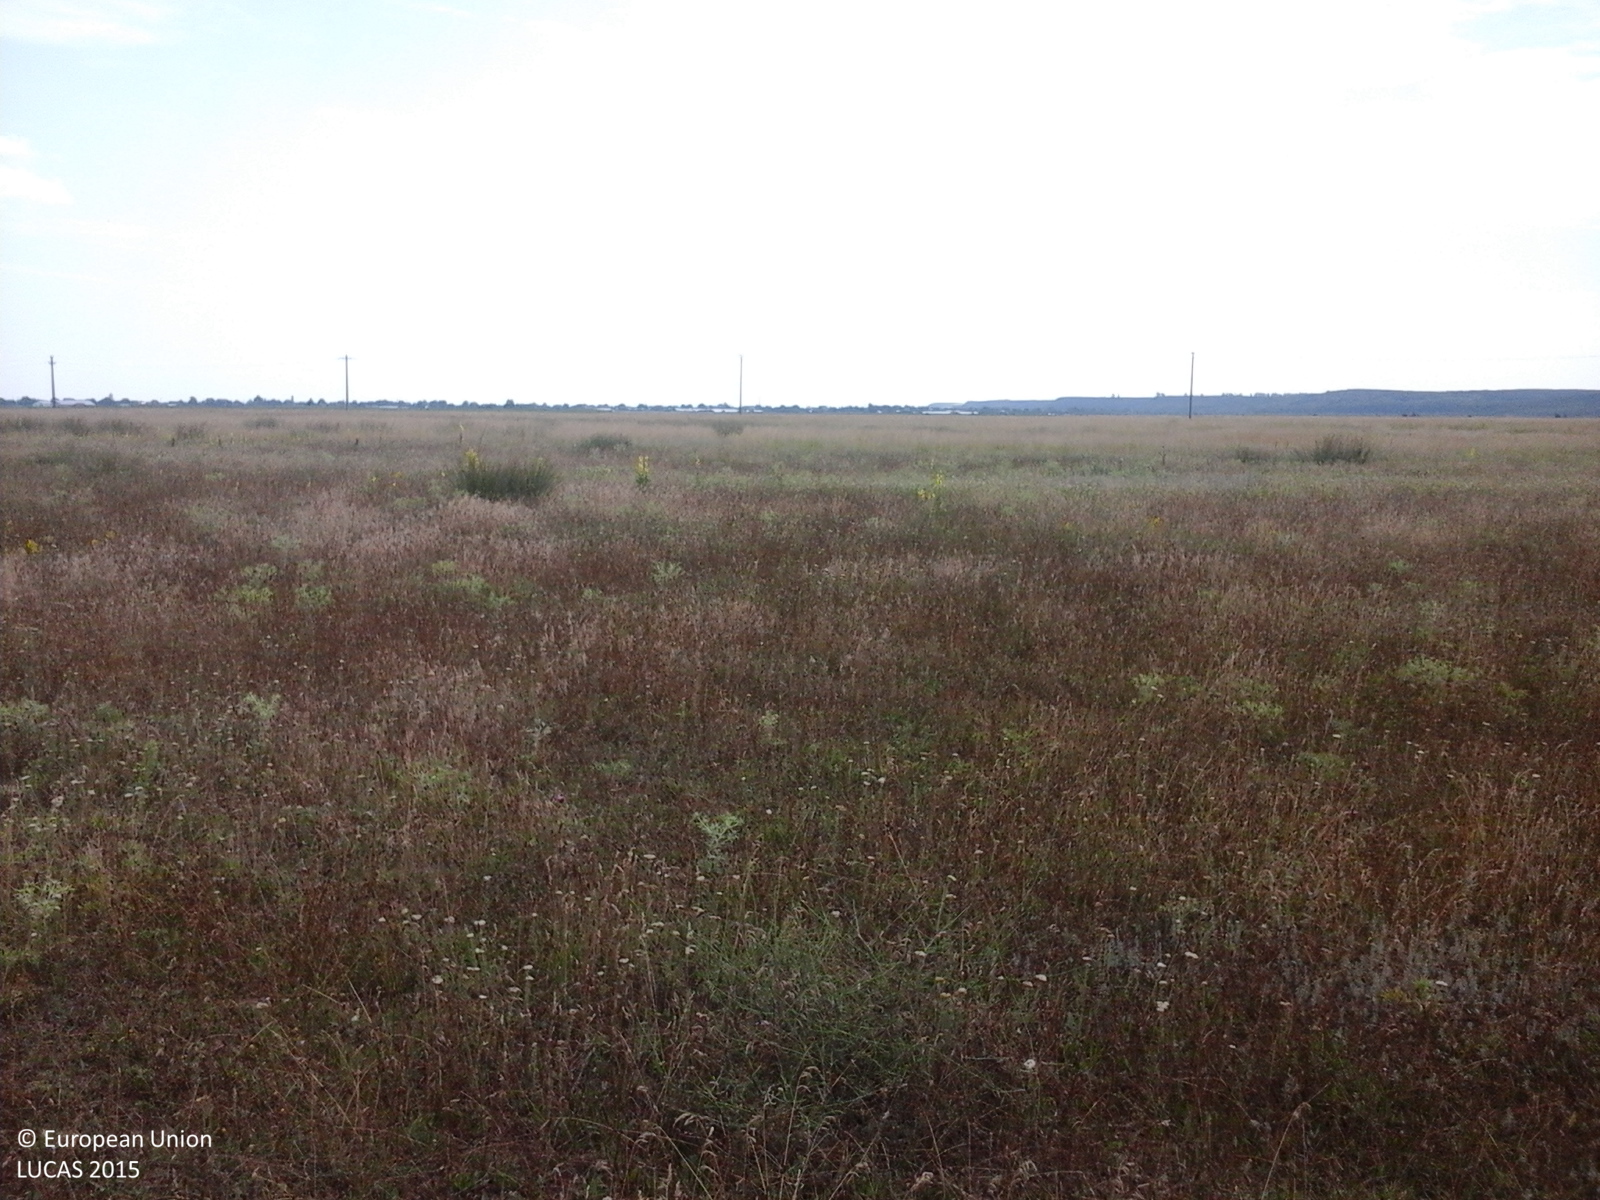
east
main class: Grassland
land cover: Grassland without tree/shrub cover
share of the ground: > 75 %
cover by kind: herbaceous plants 100 %
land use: Agriculture (excluding fallow land and kitchen gardens)
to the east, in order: Grassland without tree/shrub cover
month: June
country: RO
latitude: 44.1946
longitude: 26.1566
